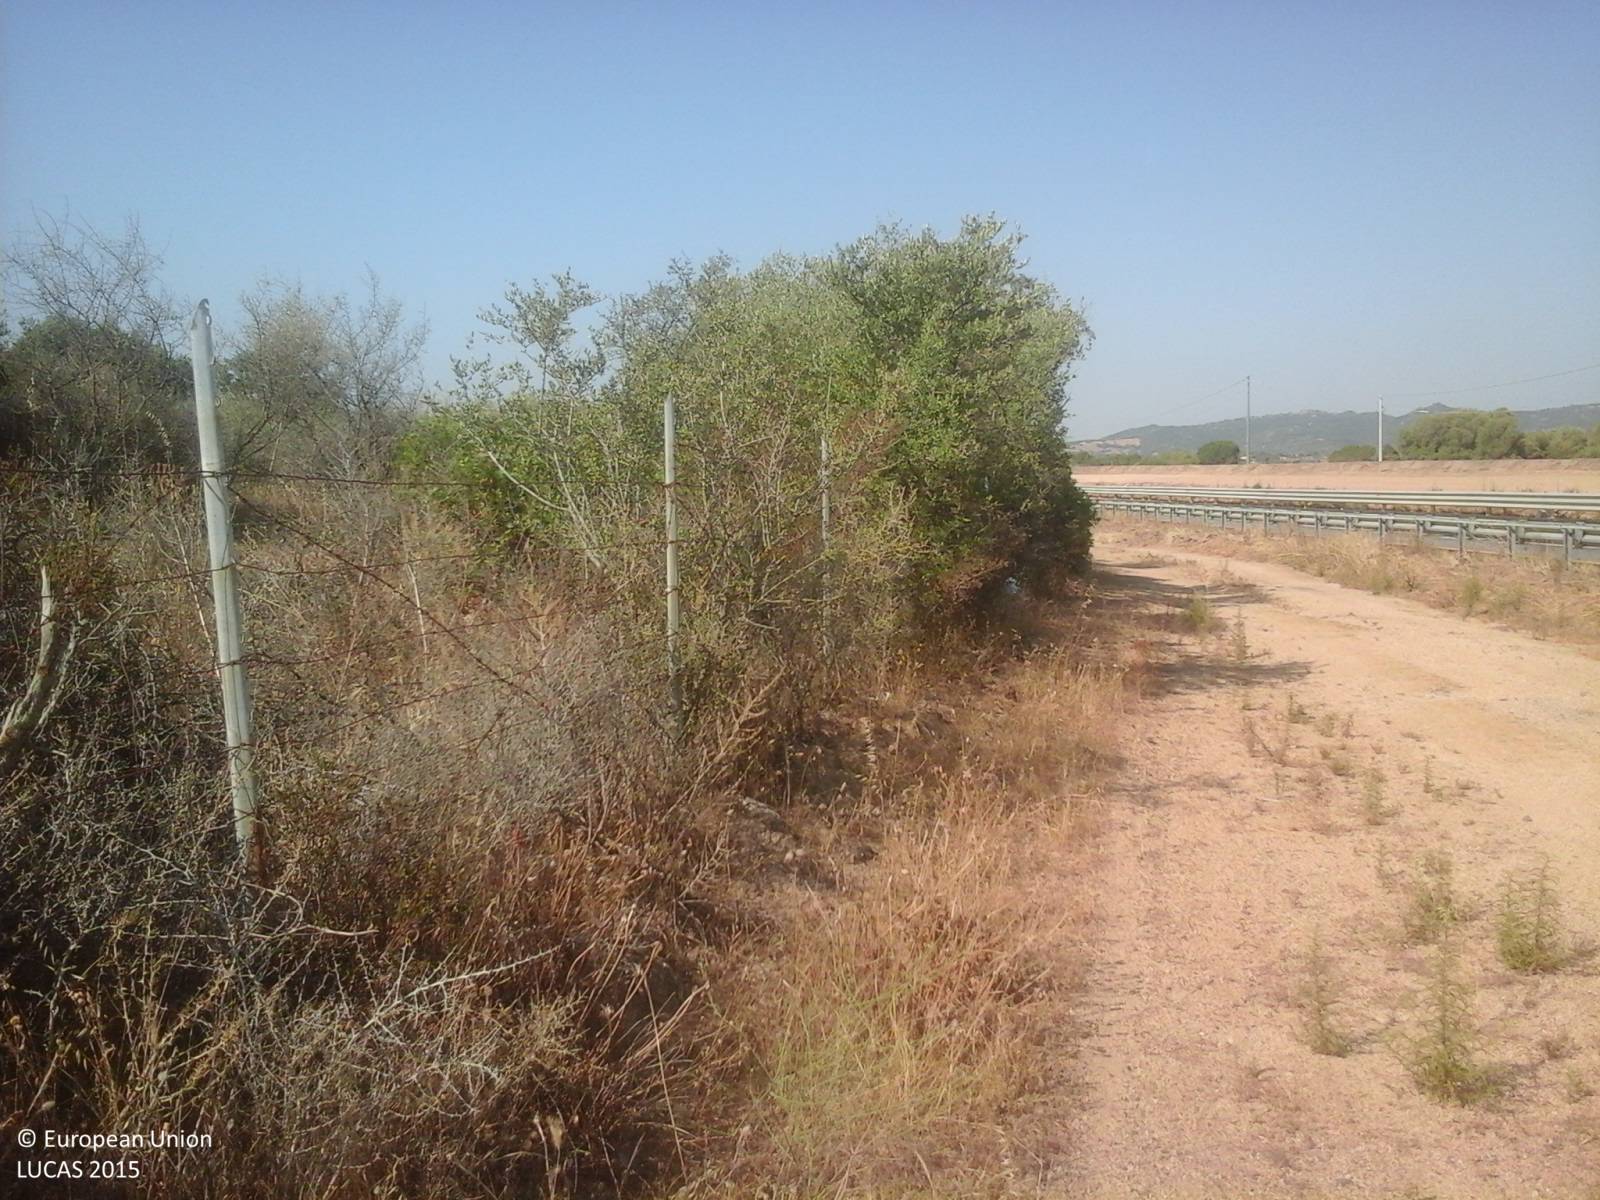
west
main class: Shrubland
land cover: Shrubland with sparse tree cover
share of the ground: > 75 %
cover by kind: shrubs 95 %, broadleaved forest trees 5 %
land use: Agriculture (excluding fallow land and kitchen gardens)
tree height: < 5 m
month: July
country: IT
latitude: 40.8812
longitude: 9.4685
